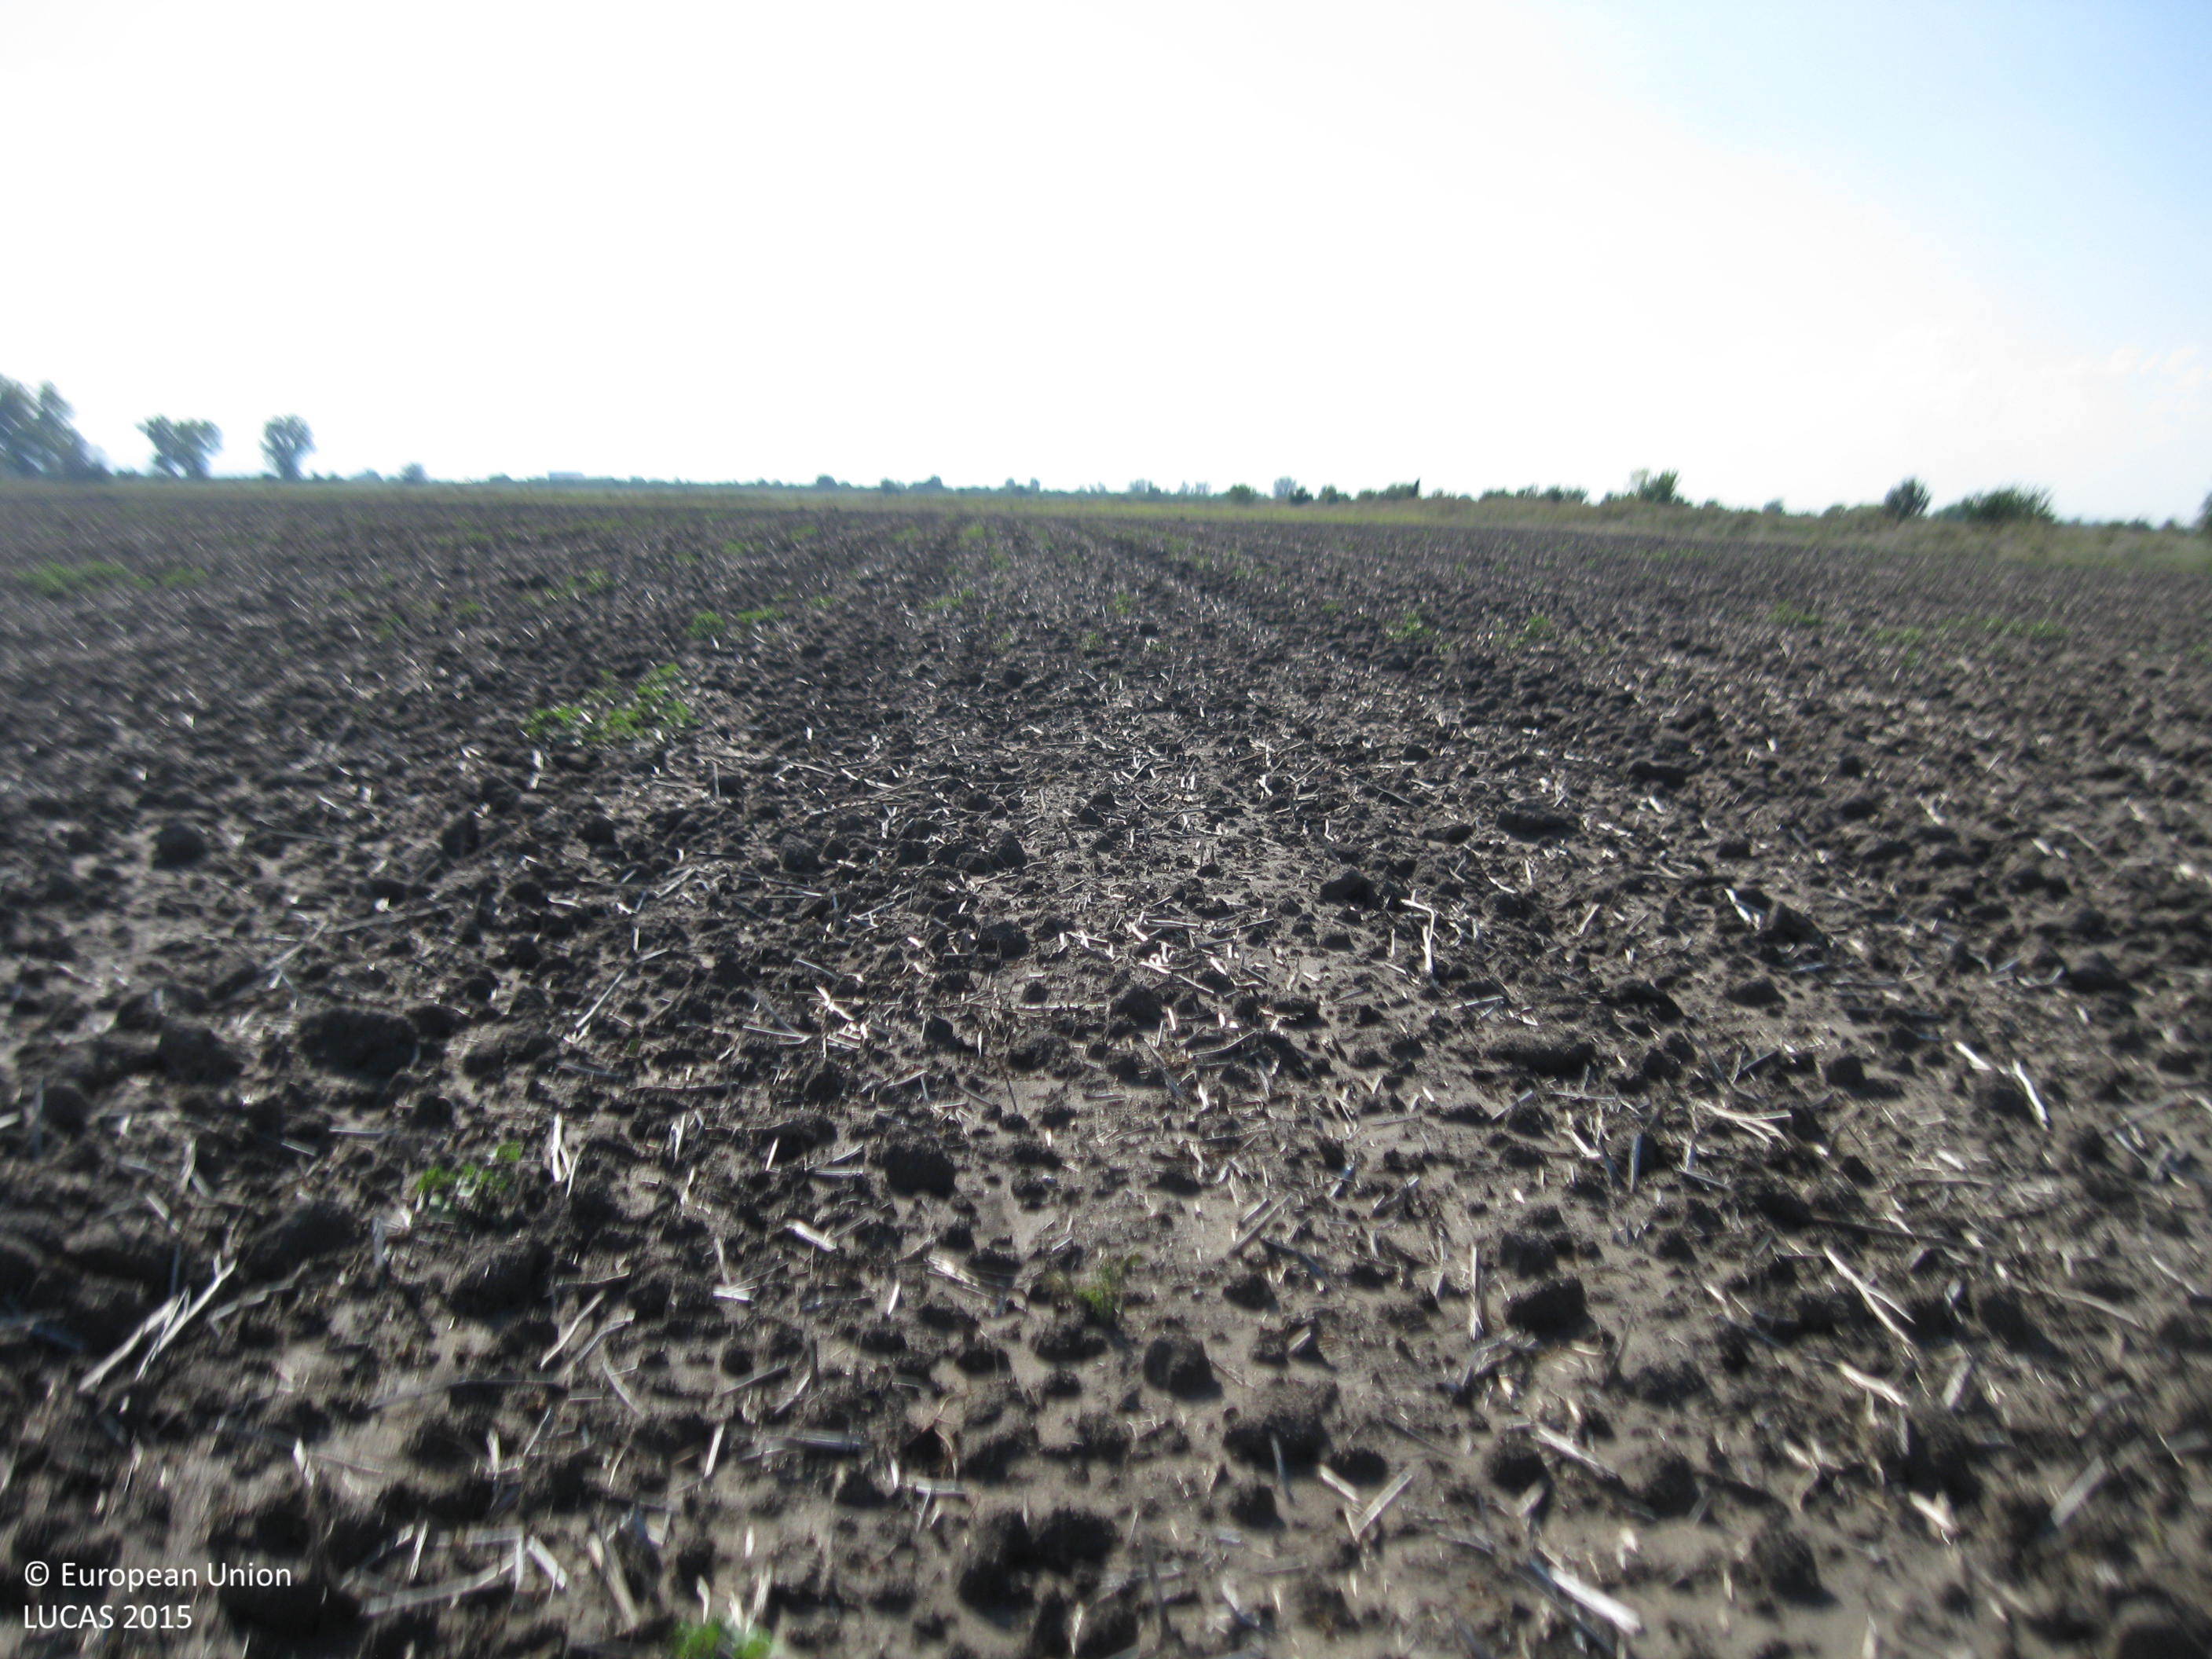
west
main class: Cropland
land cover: Sunflower
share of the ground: < 10 %
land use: Agriculture (excluding fallow land and kitchen gardens)
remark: Tilled/Sowed
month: August
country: BG
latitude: 42.1954
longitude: 24.7166
